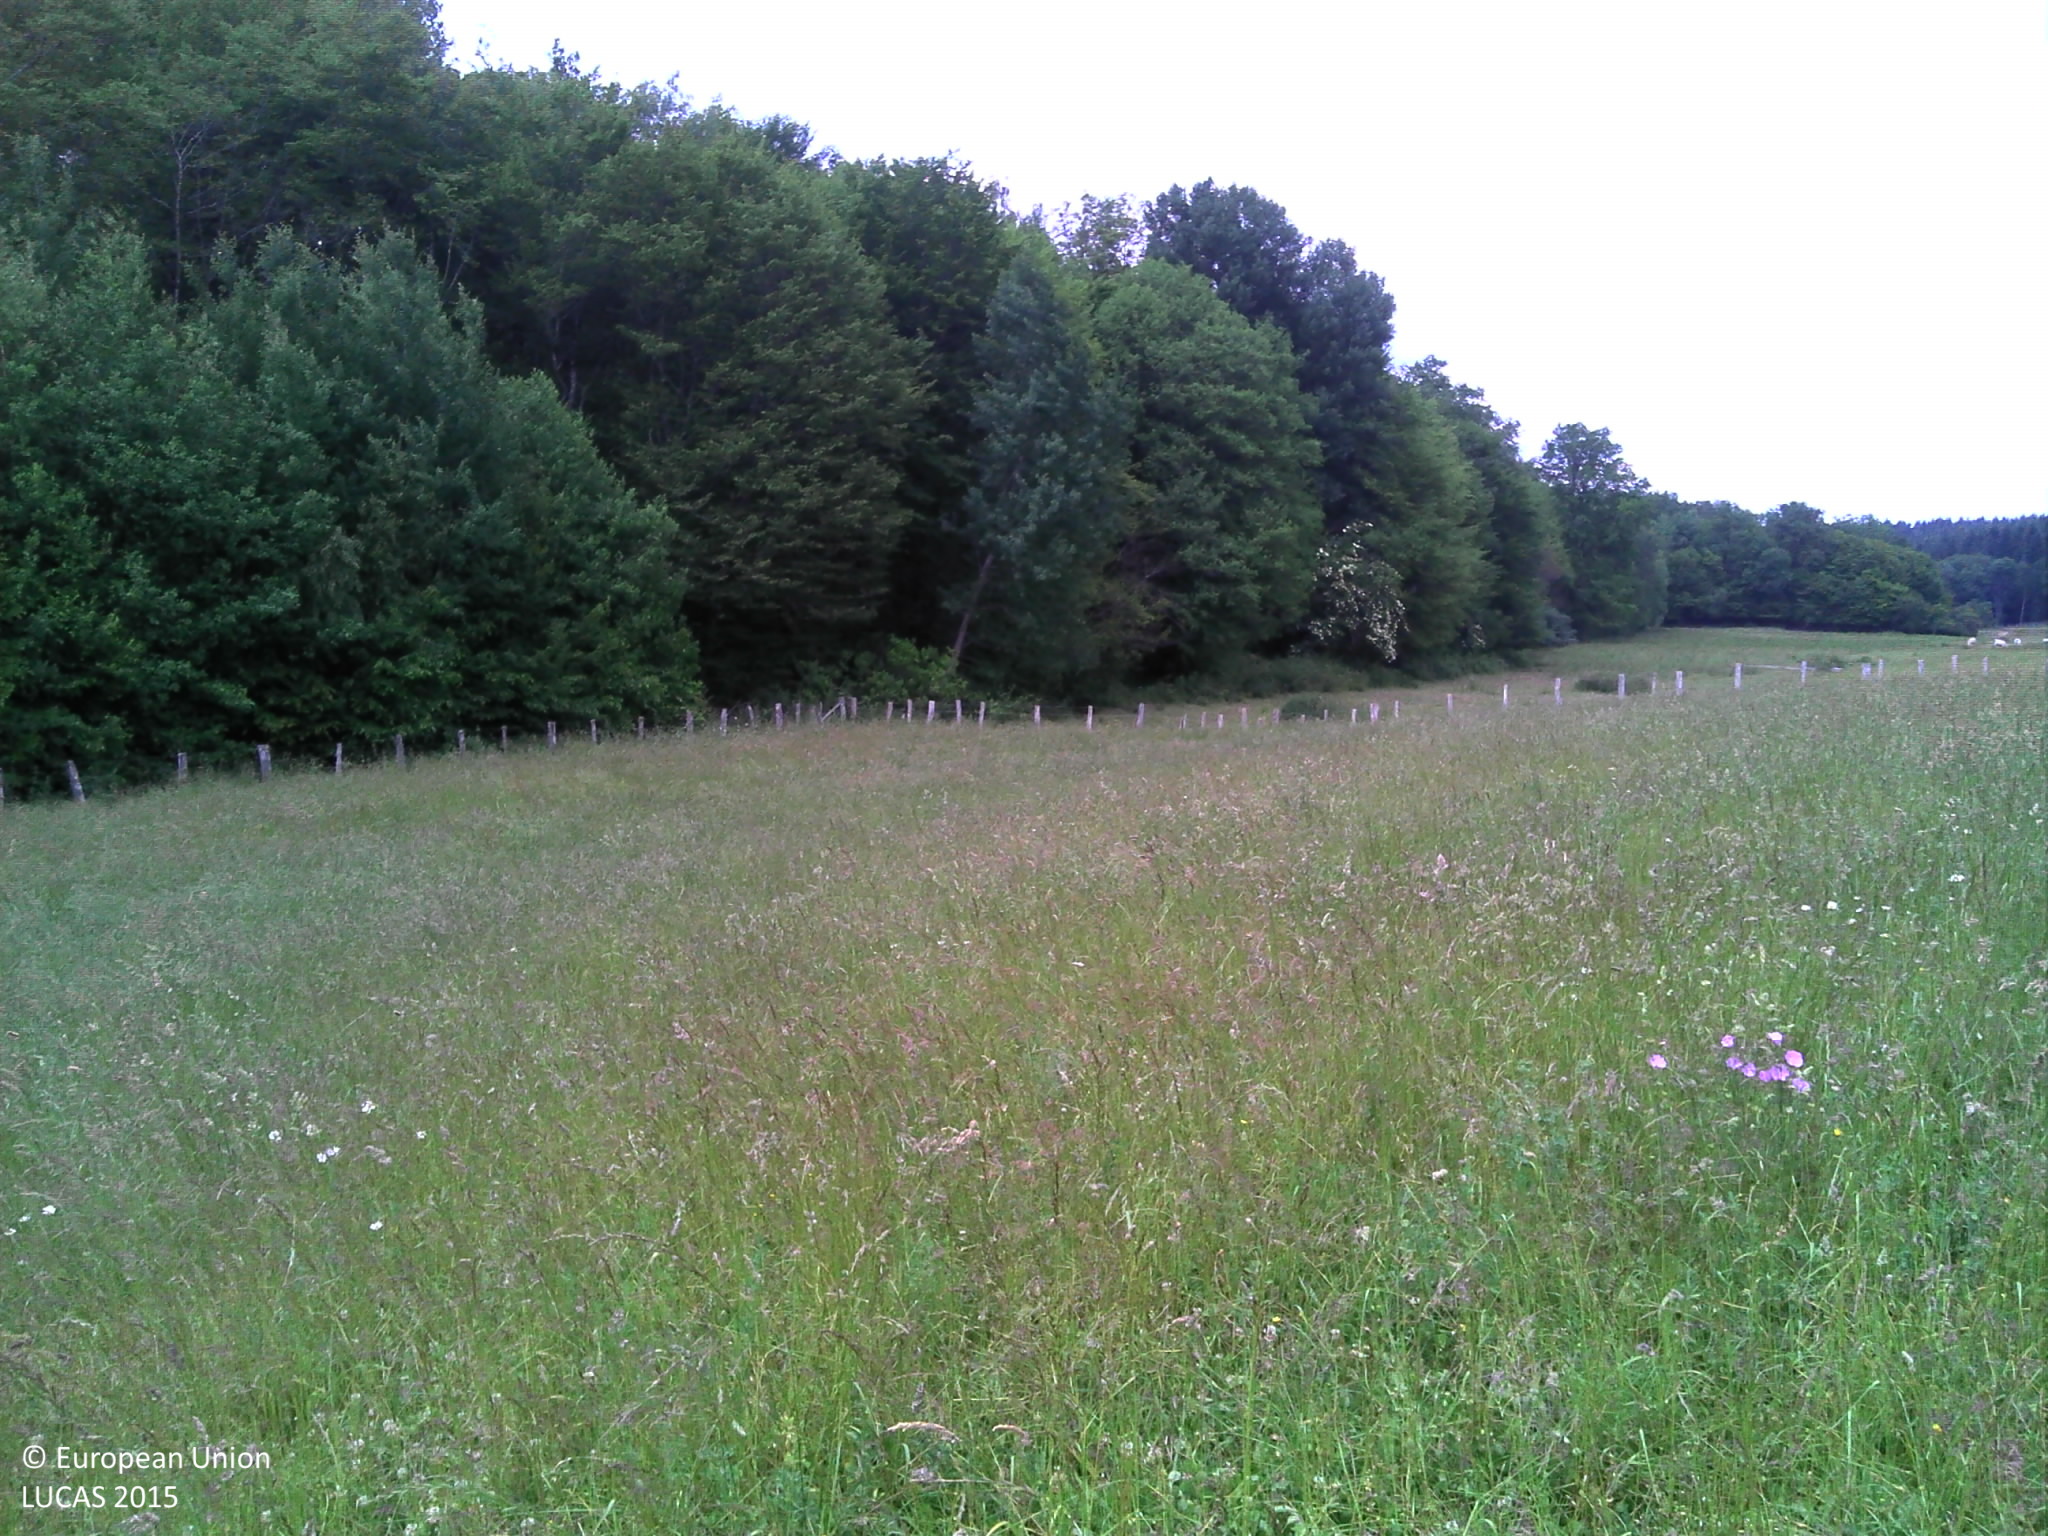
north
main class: Grassland
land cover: Grassland without tree/shrub cover
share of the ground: > 75 %
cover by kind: herbaceous plants 100 %
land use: Agriculture (excluding fallow land and kitchen gardens)
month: June
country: FR
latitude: 47.4401
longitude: 3.8847
